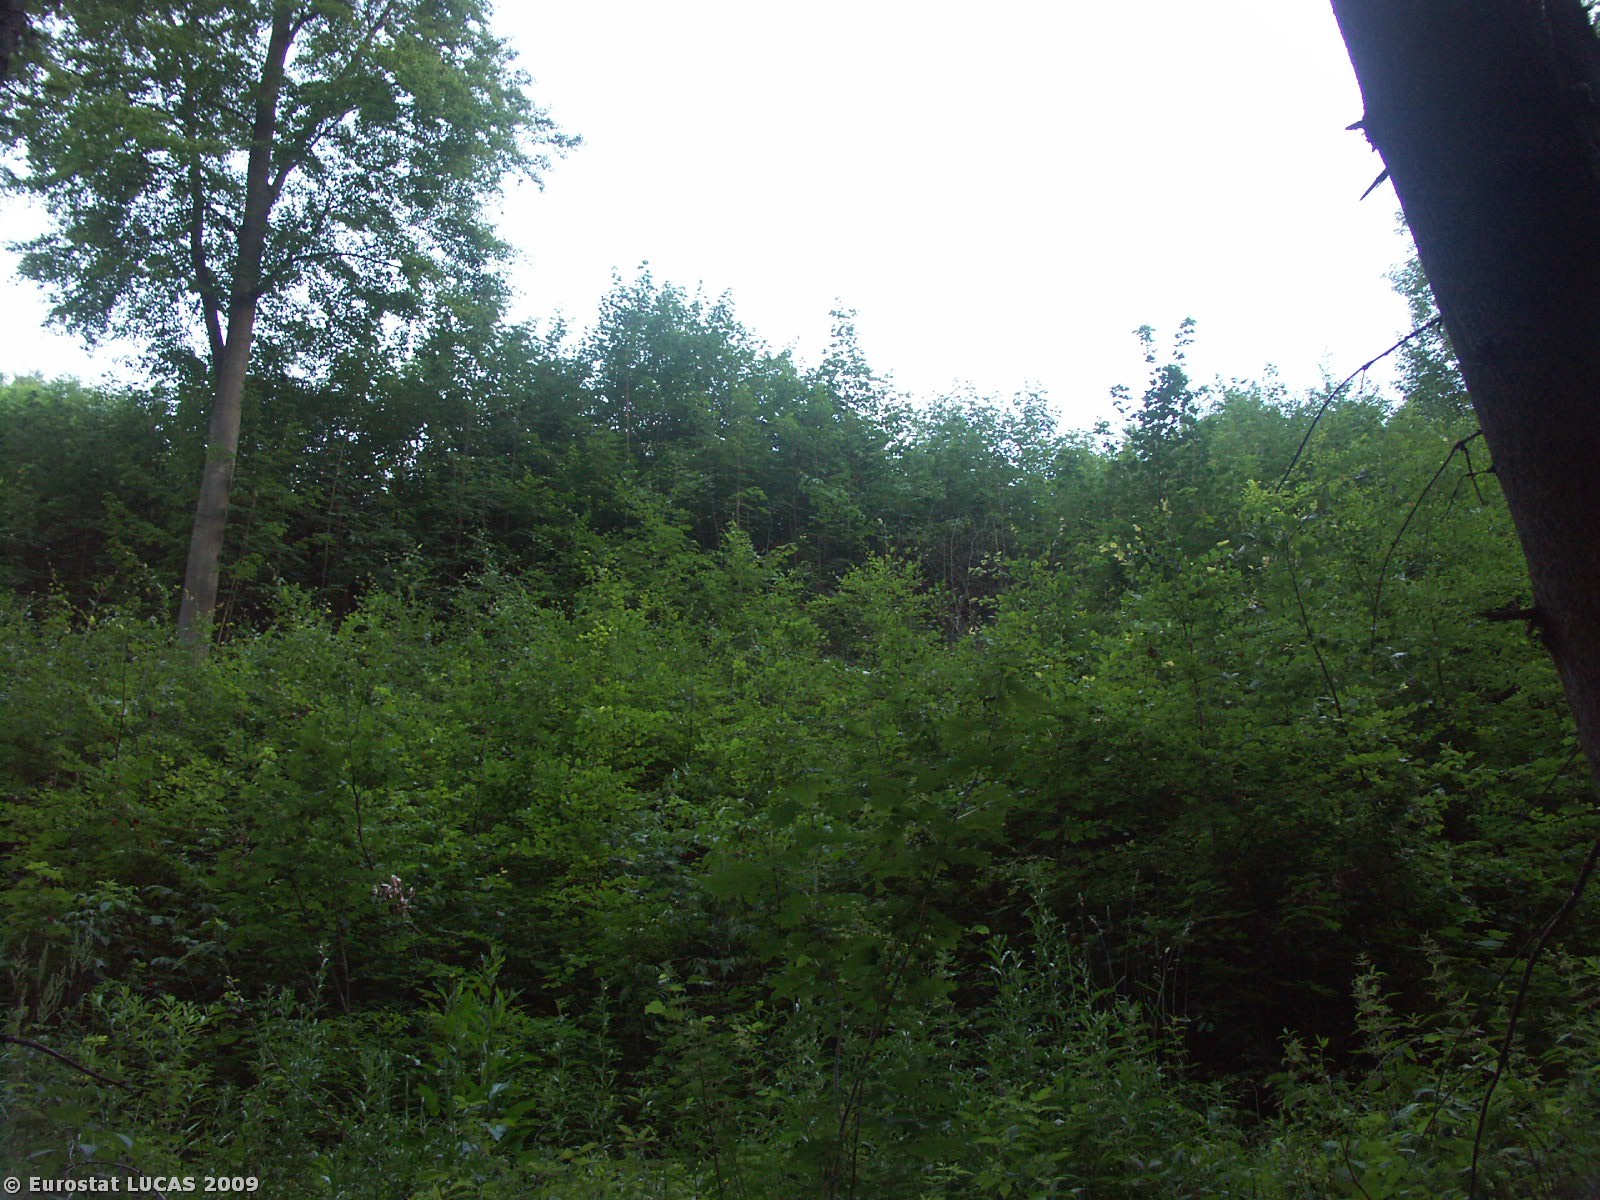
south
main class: Woodland
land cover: Coniferous woodland
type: hemiboreal forest and nemoral coniferous forest and mixed broadleaved-coniferous forest
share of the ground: > 75 %
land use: Forestry
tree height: > 5 m
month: July
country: CZ
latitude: 49.9357
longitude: 16.6539
